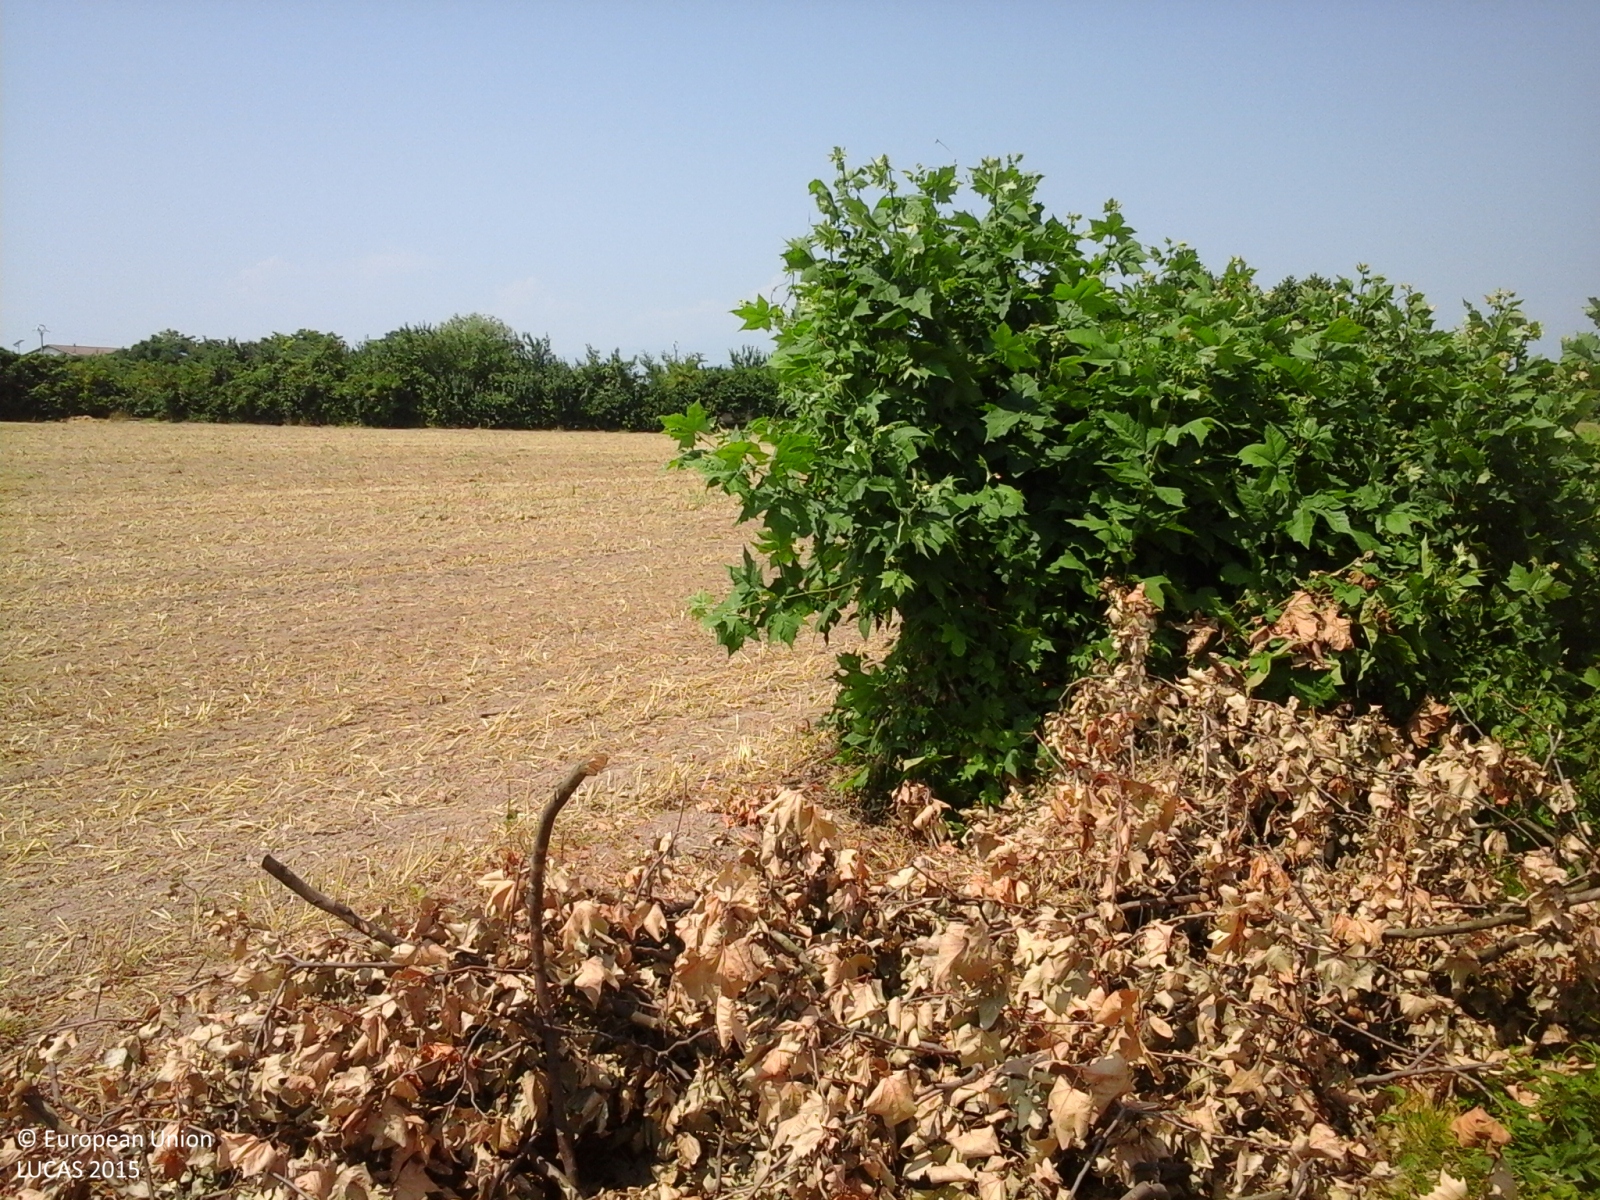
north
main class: Cropland
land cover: Barley
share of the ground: > 75 %
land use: Agriculture (excluding fallow land and kitchen gardens)
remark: Harvested field
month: July
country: IT
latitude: 45.3383
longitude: 10.9044
